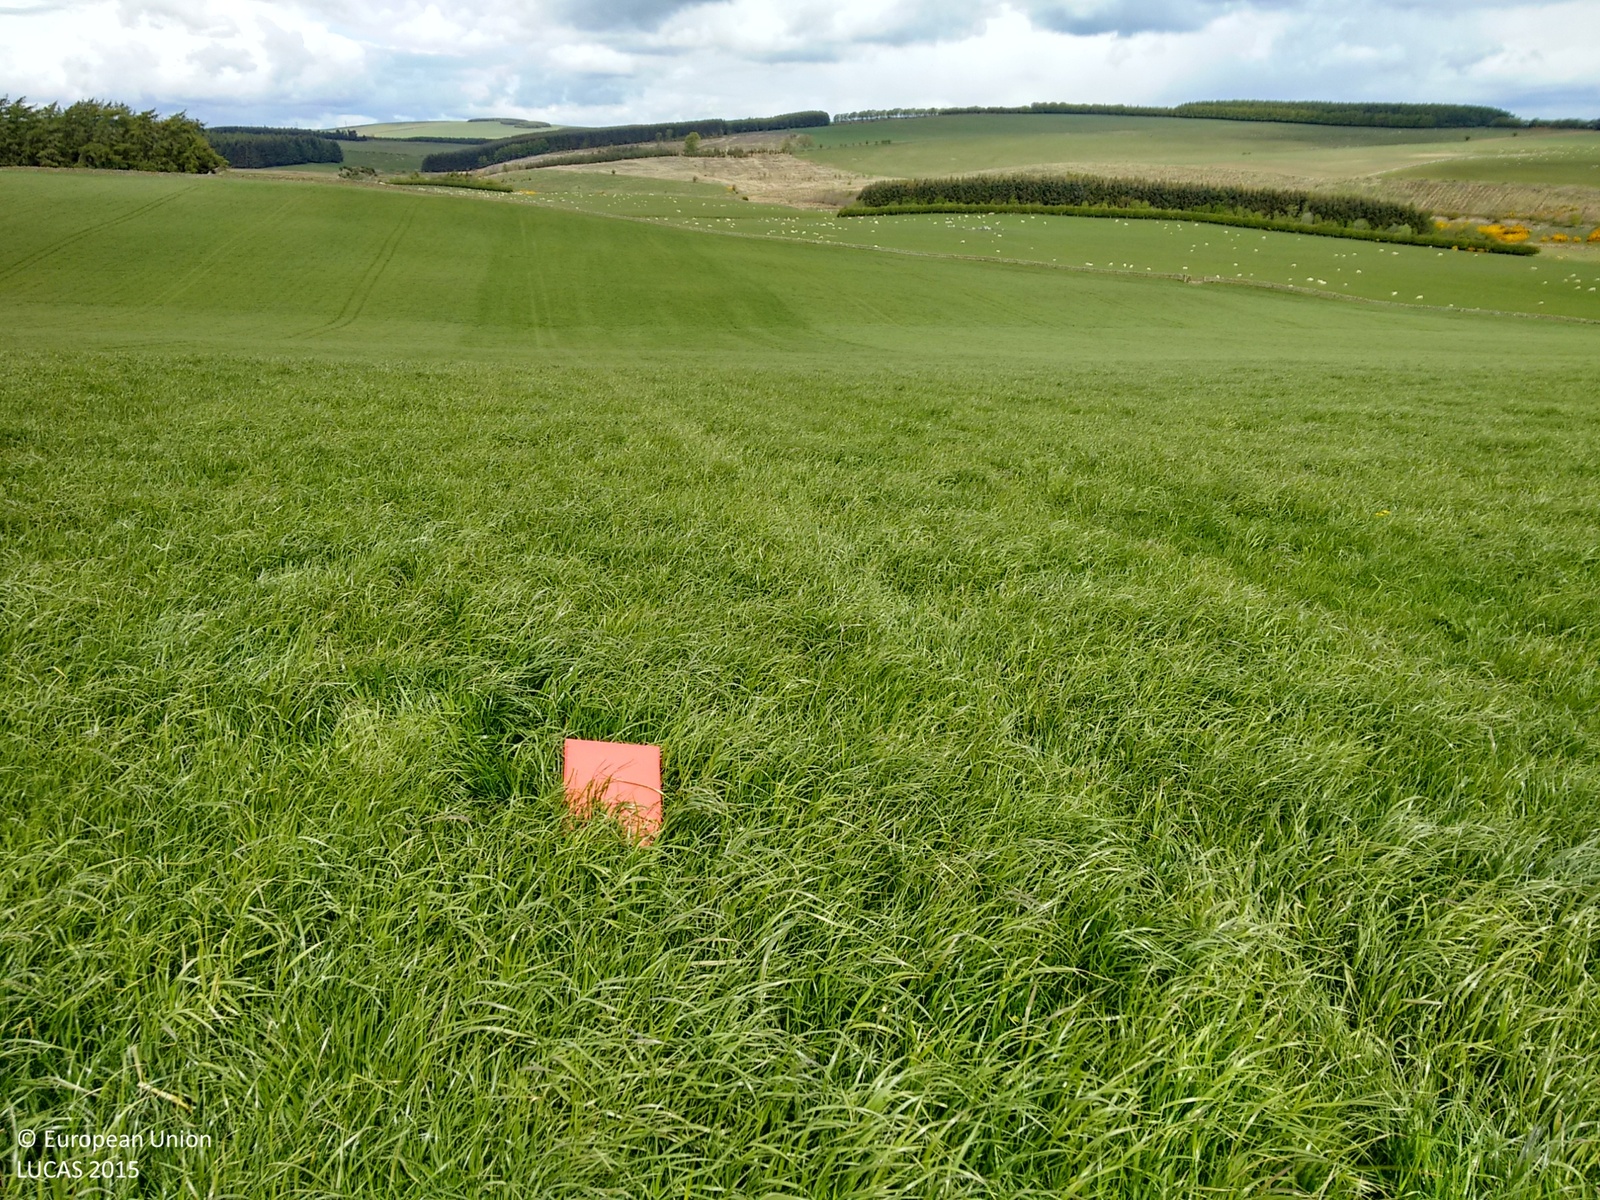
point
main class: Grassland
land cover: Grassland without tree/shrub cover
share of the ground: > 75 %
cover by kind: herbaceous plants 100 %
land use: Agriculture (excluding fallow land and kitchen gardens)
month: May
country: GB
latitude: 55.8621
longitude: -2.3441
